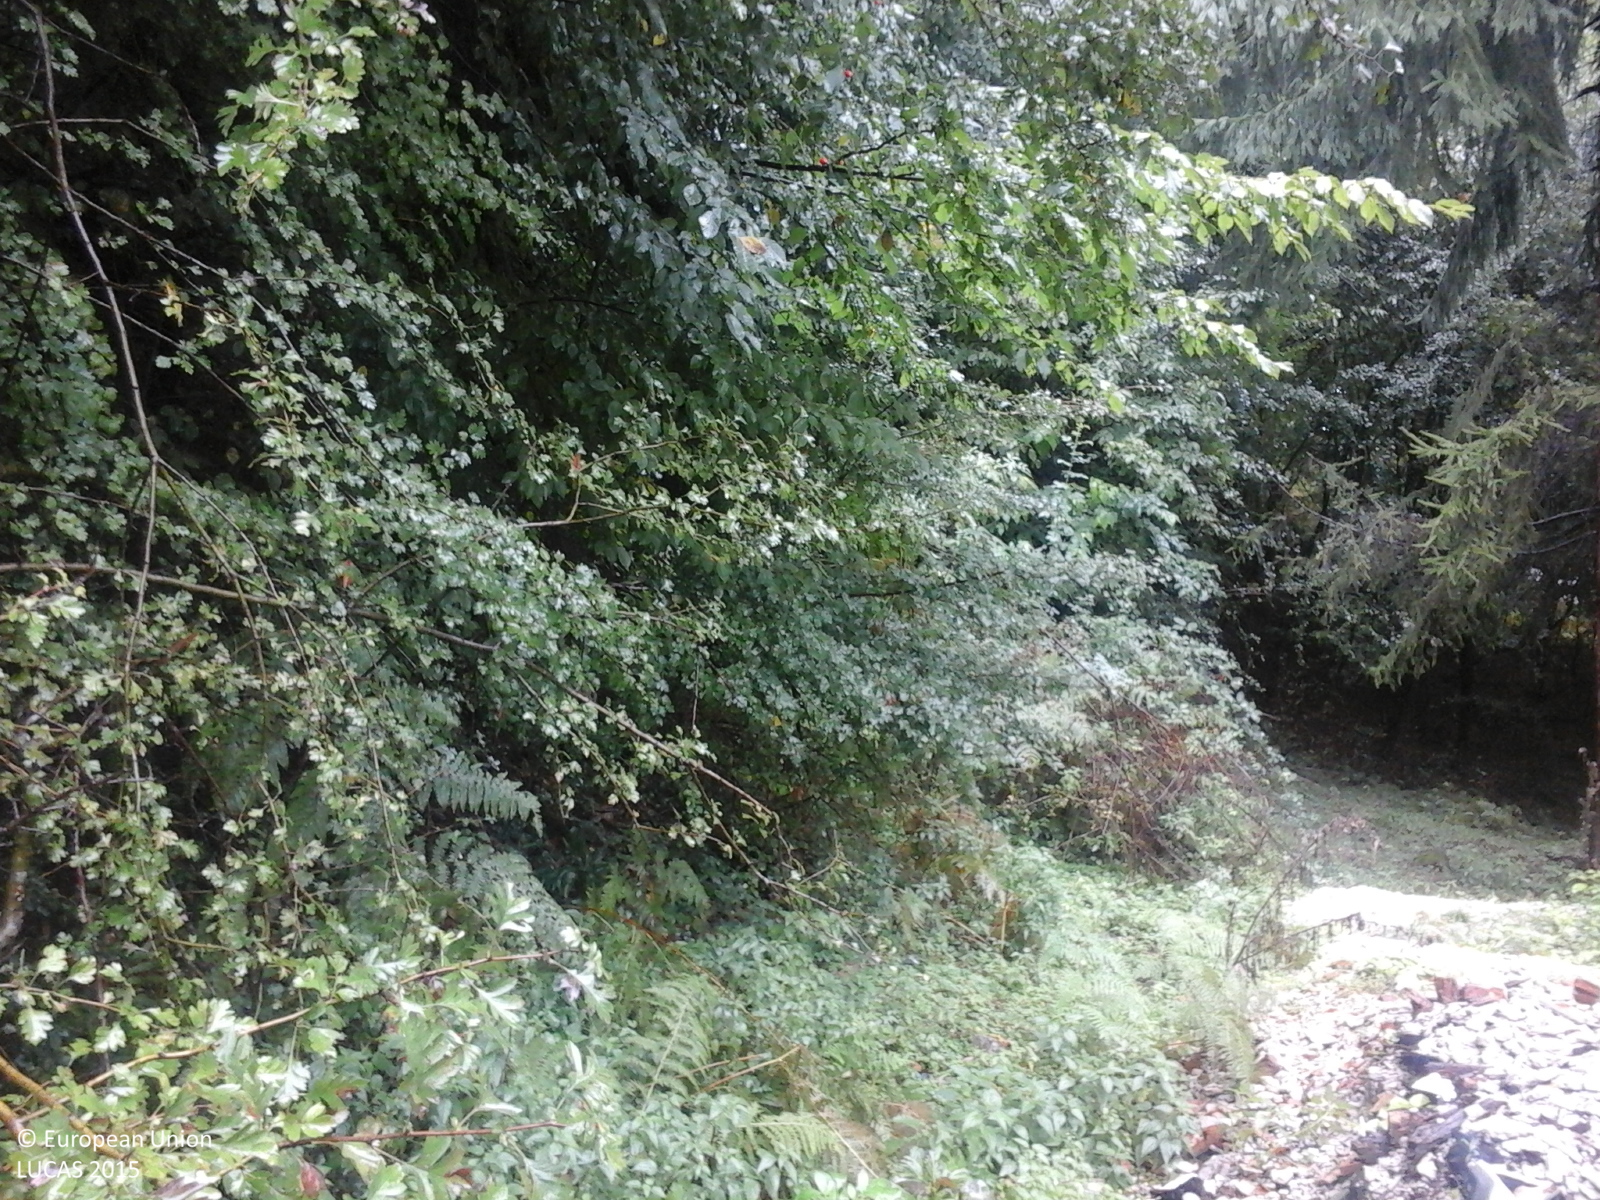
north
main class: Artificial land
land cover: Non built-up area features
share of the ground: > 75 %
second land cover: Spontaneously vegetated surfaces
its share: > 75 %
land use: Abandoned areas
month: September
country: RO
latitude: 45.2026
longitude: 23.7487
